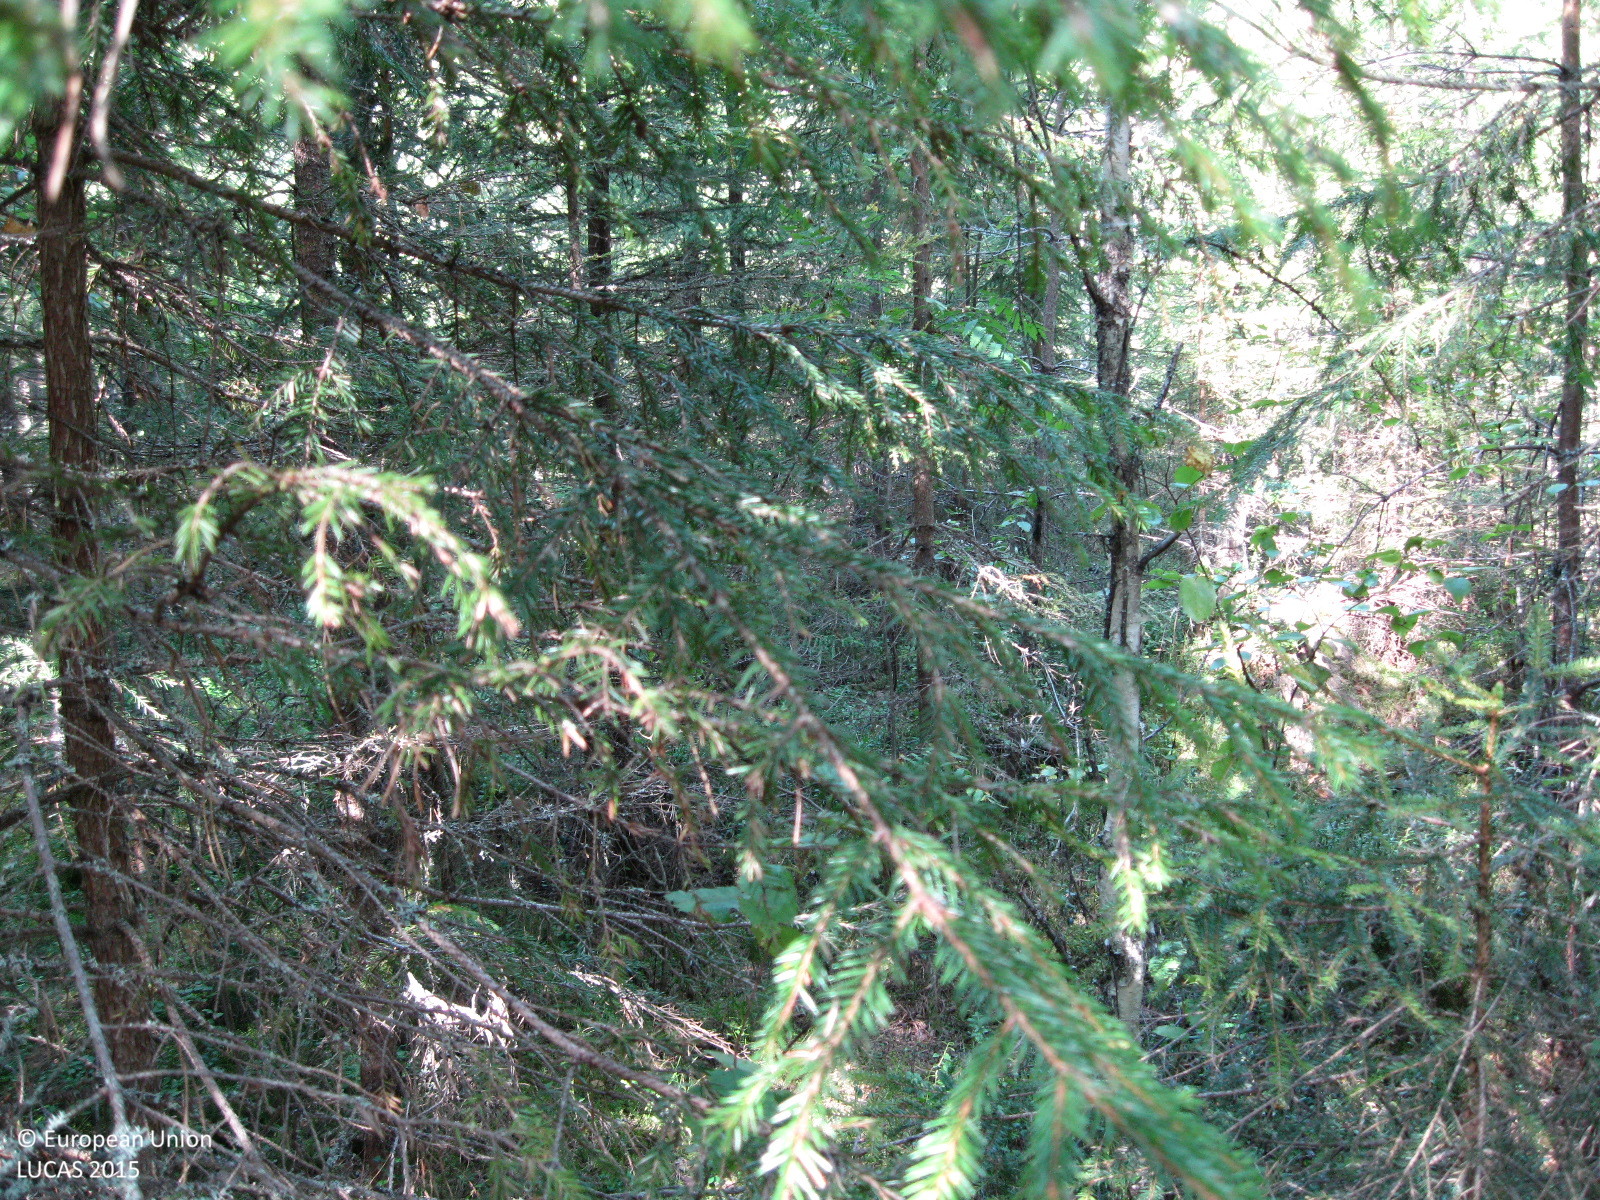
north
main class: Woodland
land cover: Other mixed woodland
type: boreal forest
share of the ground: > 75 %
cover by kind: coniferous forest trees 65 %, broadleaved forest trees 25 %, shrubs 5 %, lichens and mosses 5 %
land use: Forestry
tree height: > 5 m
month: August
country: FI
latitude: 61.4223
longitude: 25.0853
